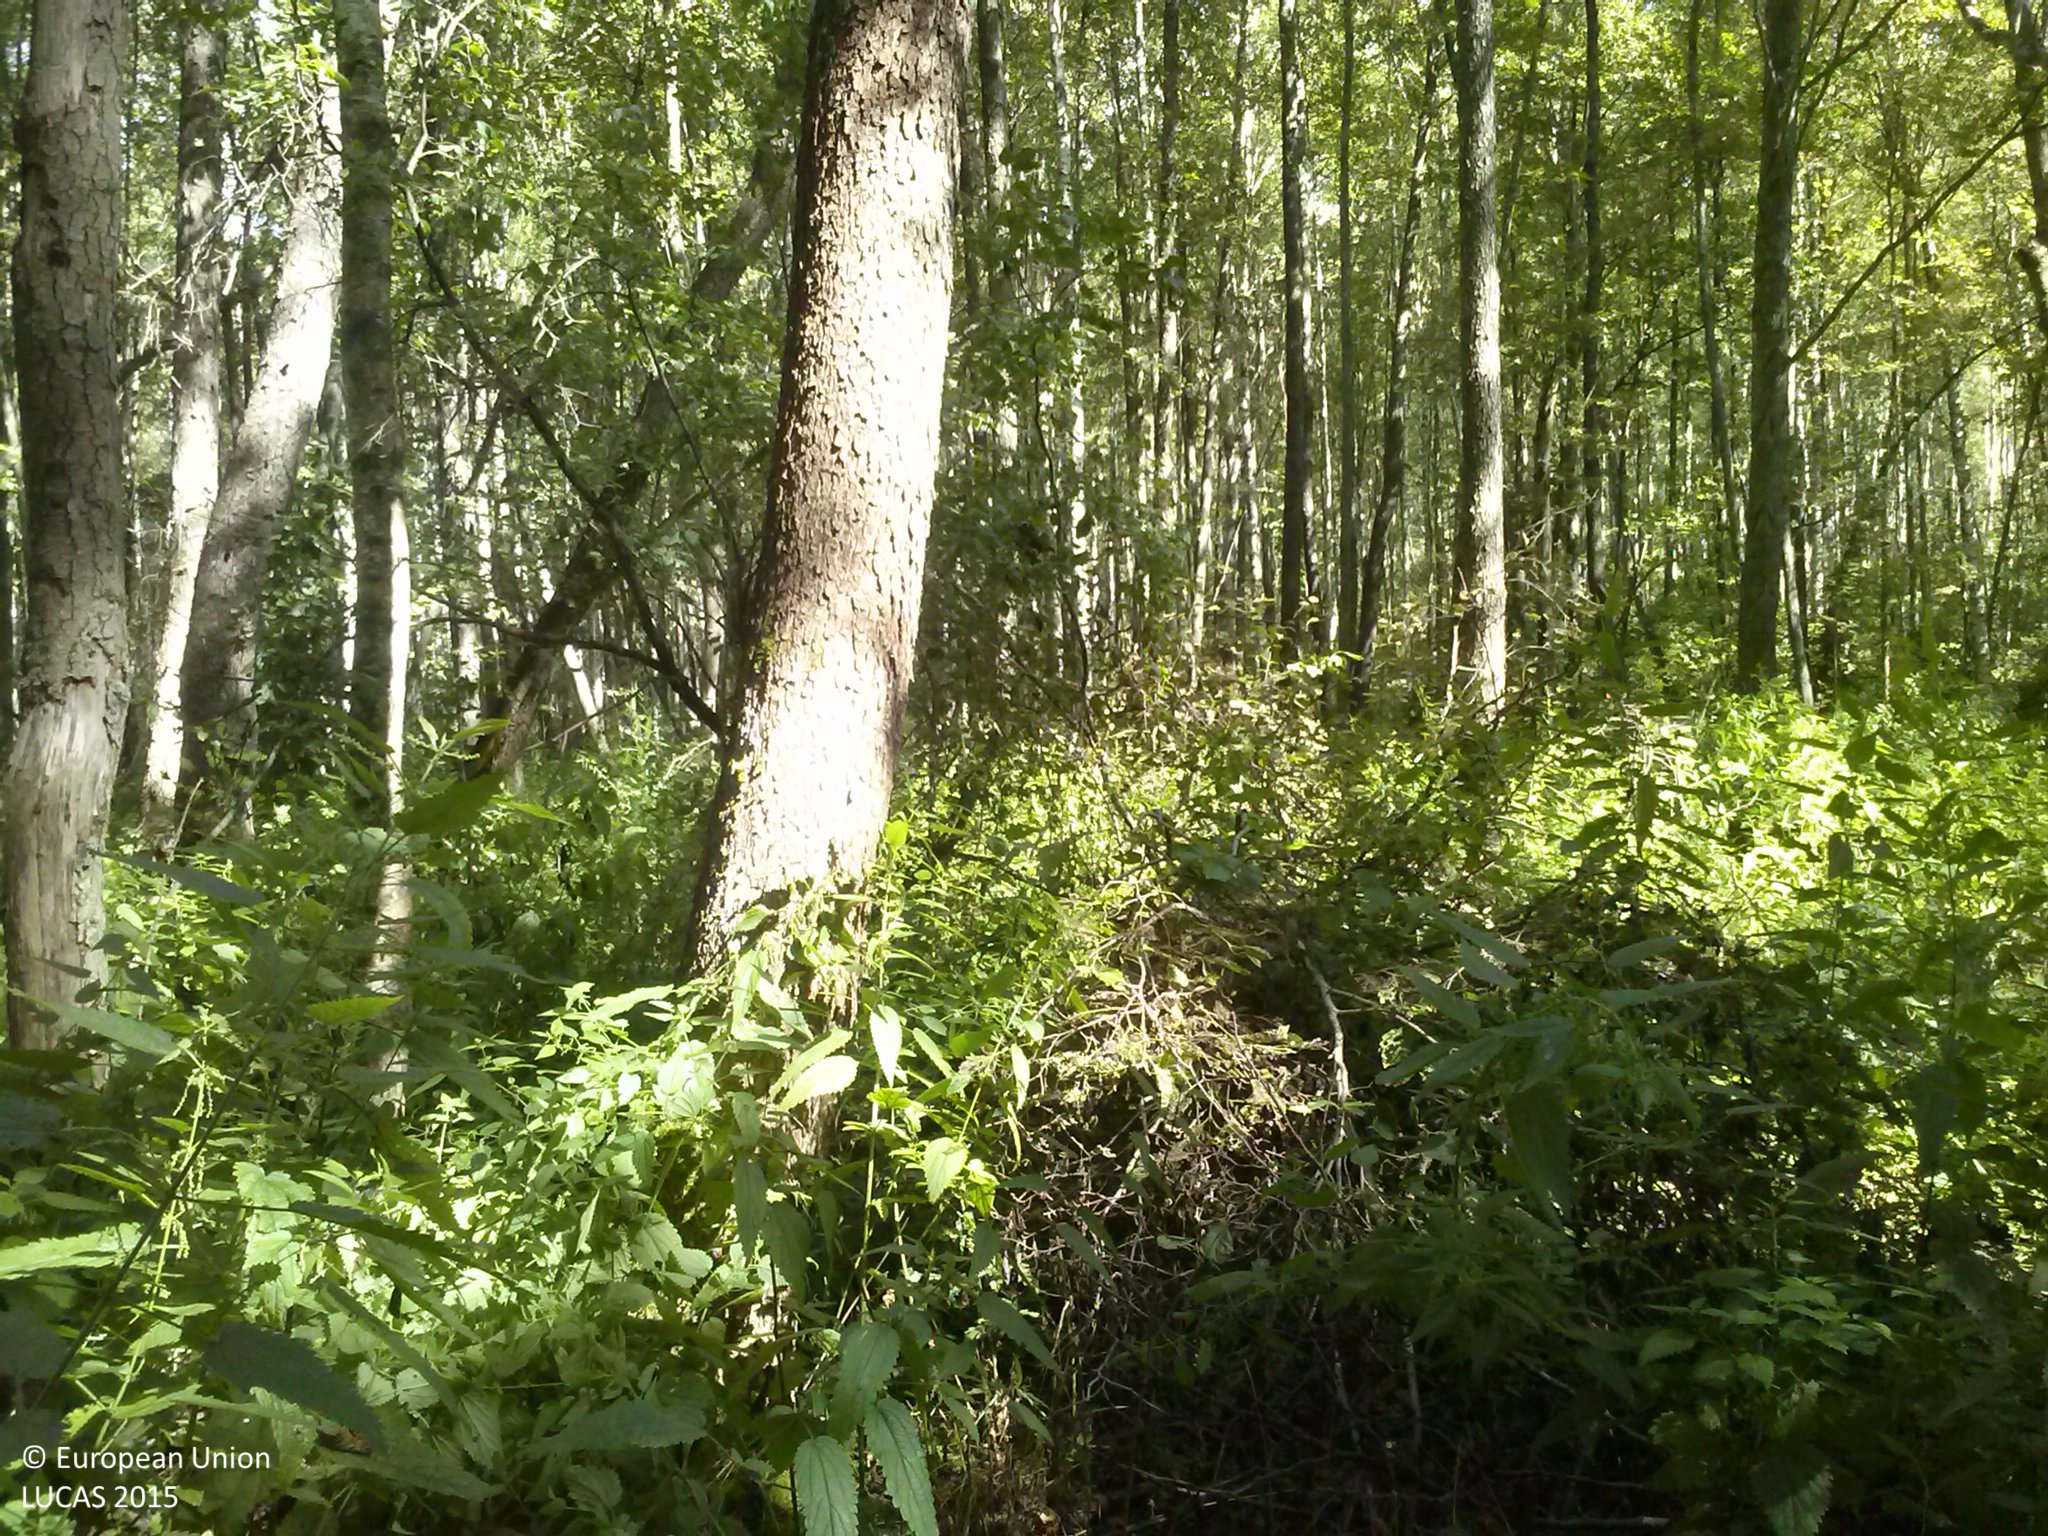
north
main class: Woodland
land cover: Broadleaved woodland
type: non-riverine alder, birch or aspen forest
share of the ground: > 75 %
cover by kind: broadleaved forest trees 75 %, herbaceous plants 25 %
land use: Forestry
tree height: > 5 m
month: August
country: LV
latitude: 56.1254
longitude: 26.7425
